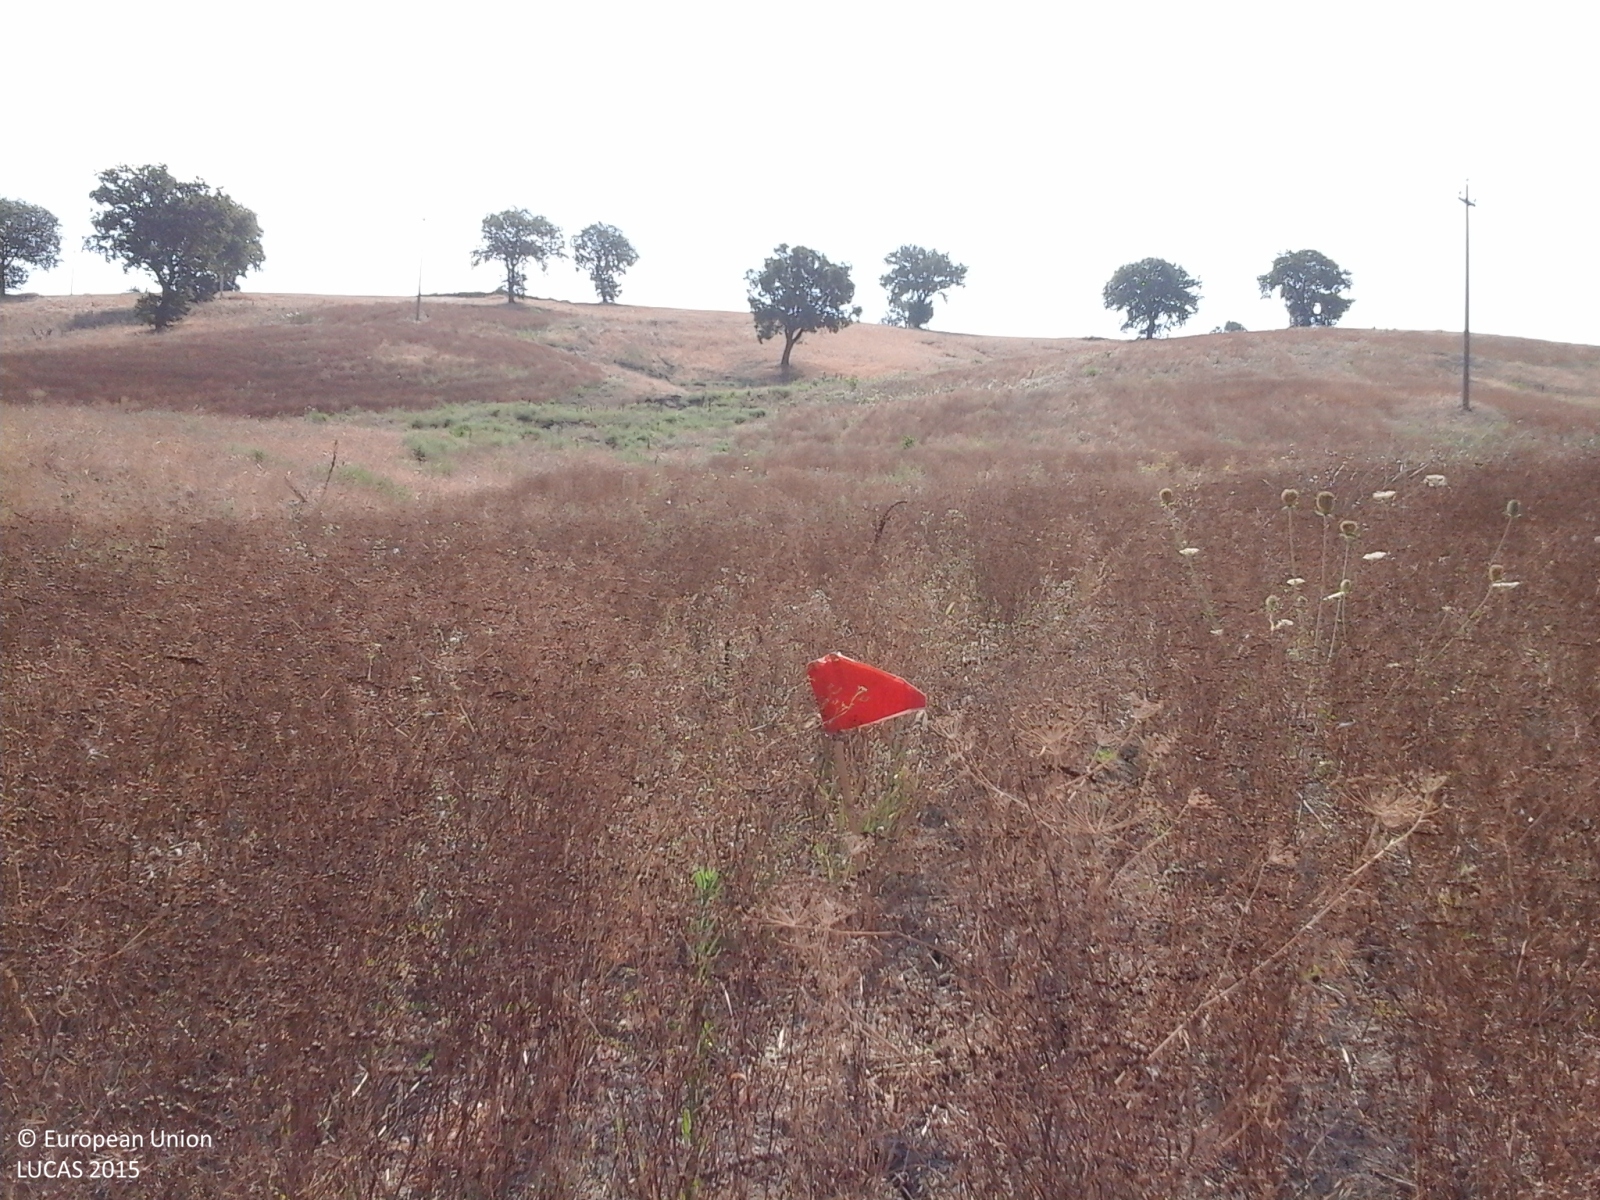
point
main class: Cropland
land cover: Other non-permanent industrial crops
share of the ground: > 75 %
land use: Agriculture (excluding fallow land and kitchen gardens)
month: August
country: IT
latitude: 41.8926
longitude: 14.7215
